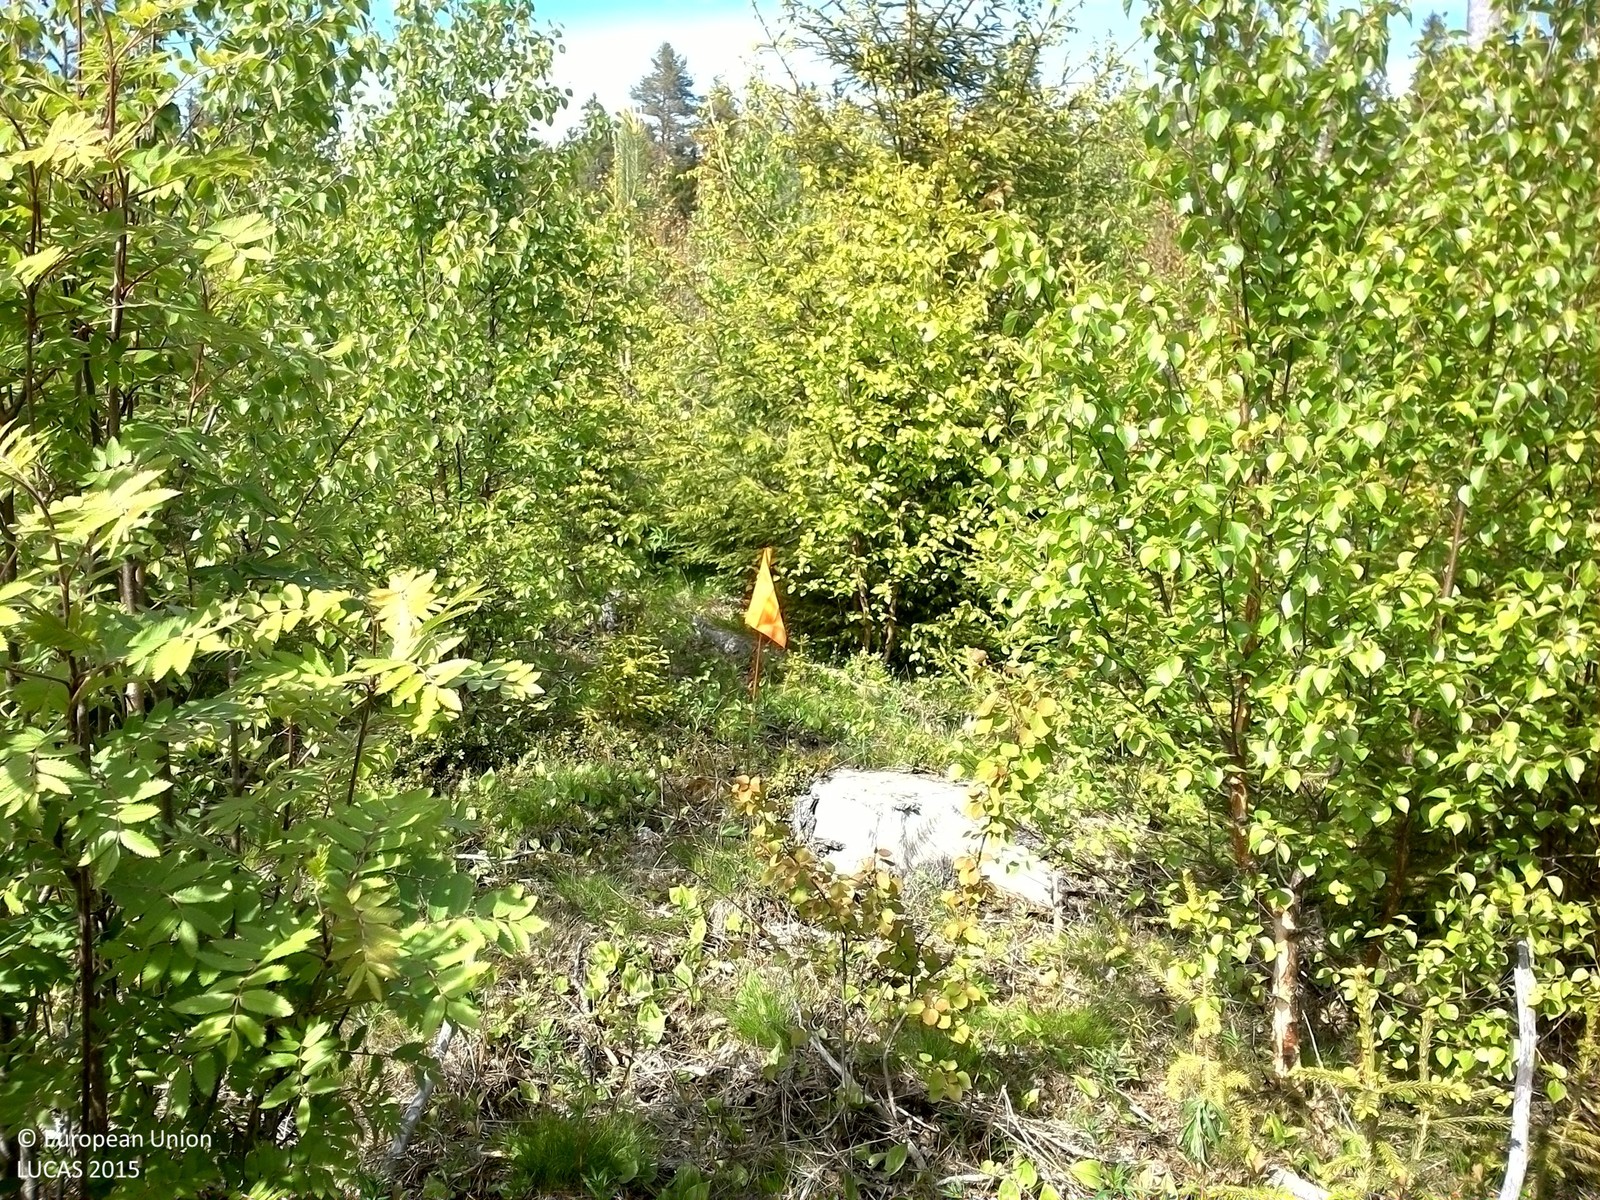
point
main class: Woodland
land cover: Broadleaved woodland
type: boreal forest
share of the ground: 50 - 75 %
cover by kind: broadleaved forest trees 60 %, herbaceous plants 20 %, coniferous forest trees 10 %, shrubs 10 %
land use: Forestry
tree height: < 5 m
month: June
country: SE
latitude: 62.6675
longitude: 17.7299
